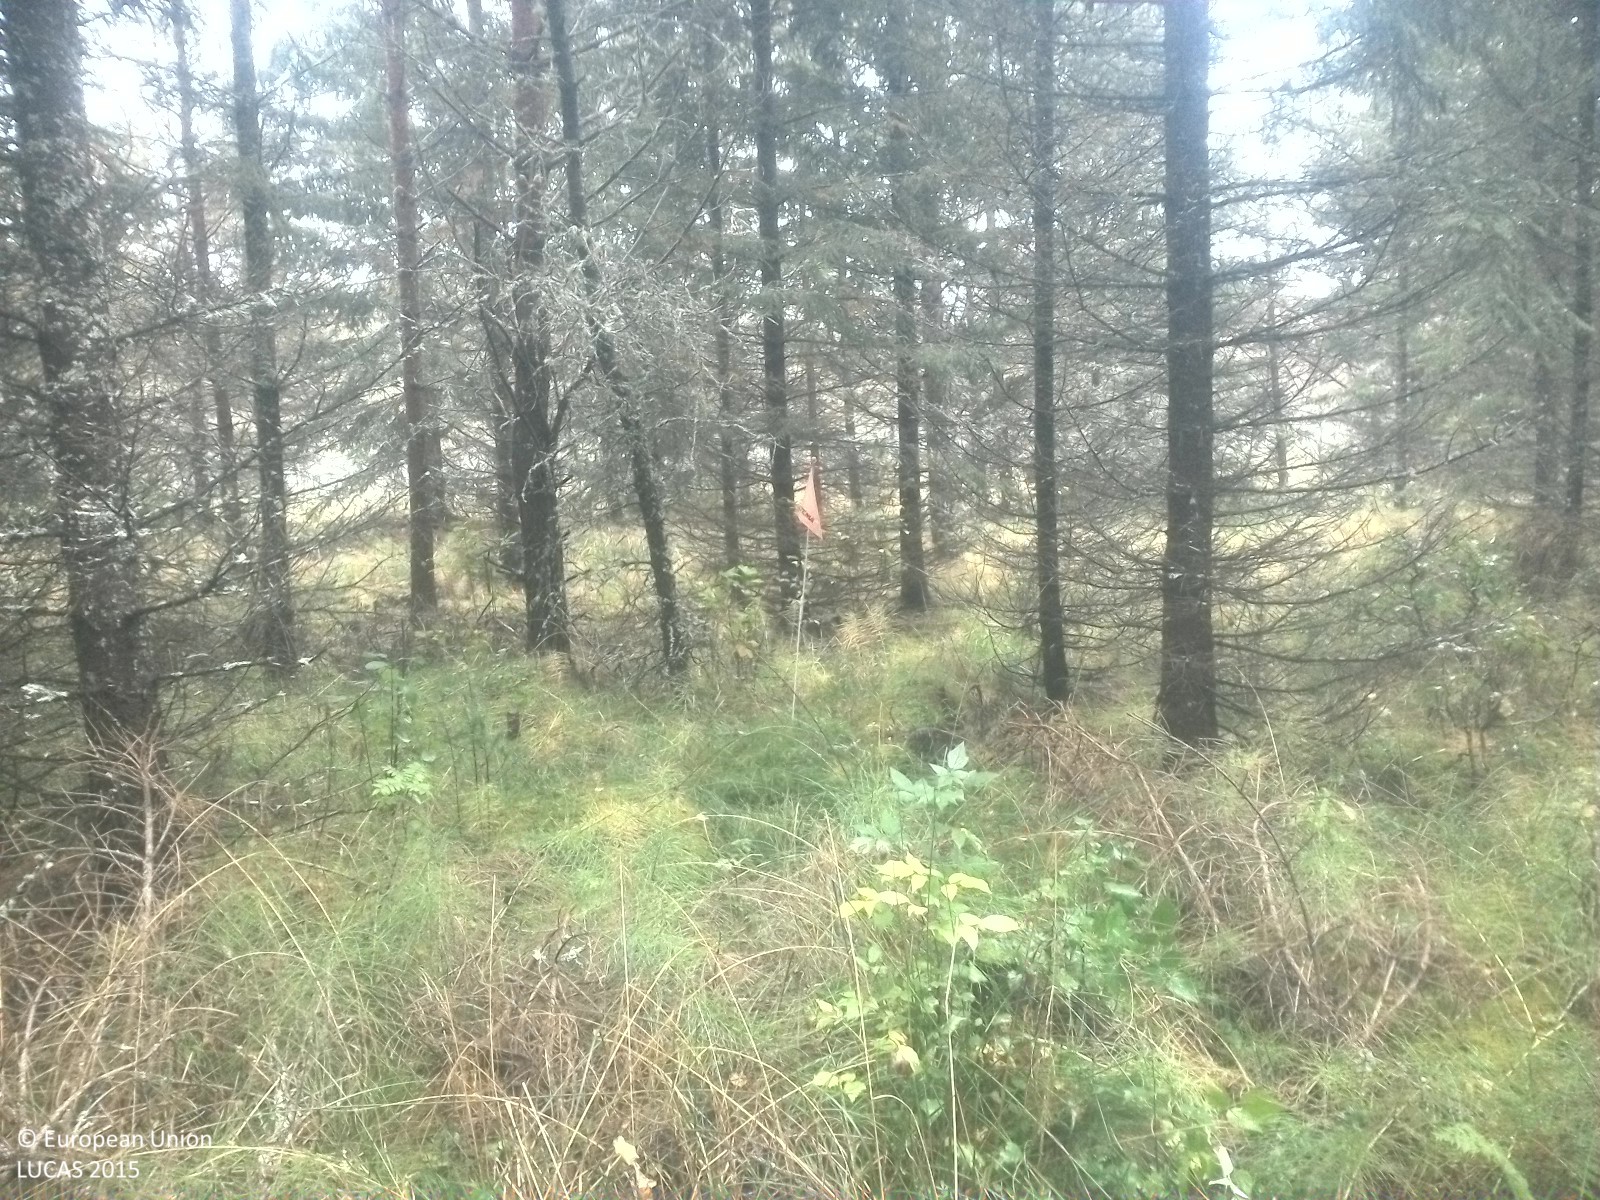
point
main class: Woodland
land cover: Spruce dominated coniferous woodland
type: boreal forest
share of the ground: 50 - 75 %
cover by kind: coniferous forest trees 50 %, herbaceous plants 35 %, broadleaved forest trees 5 %, shrubs 5 %, lichens and mosses 5 %
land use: Forestry
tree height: > 5 m
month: September
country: SE
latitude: 58.5734
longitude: 16.7542
